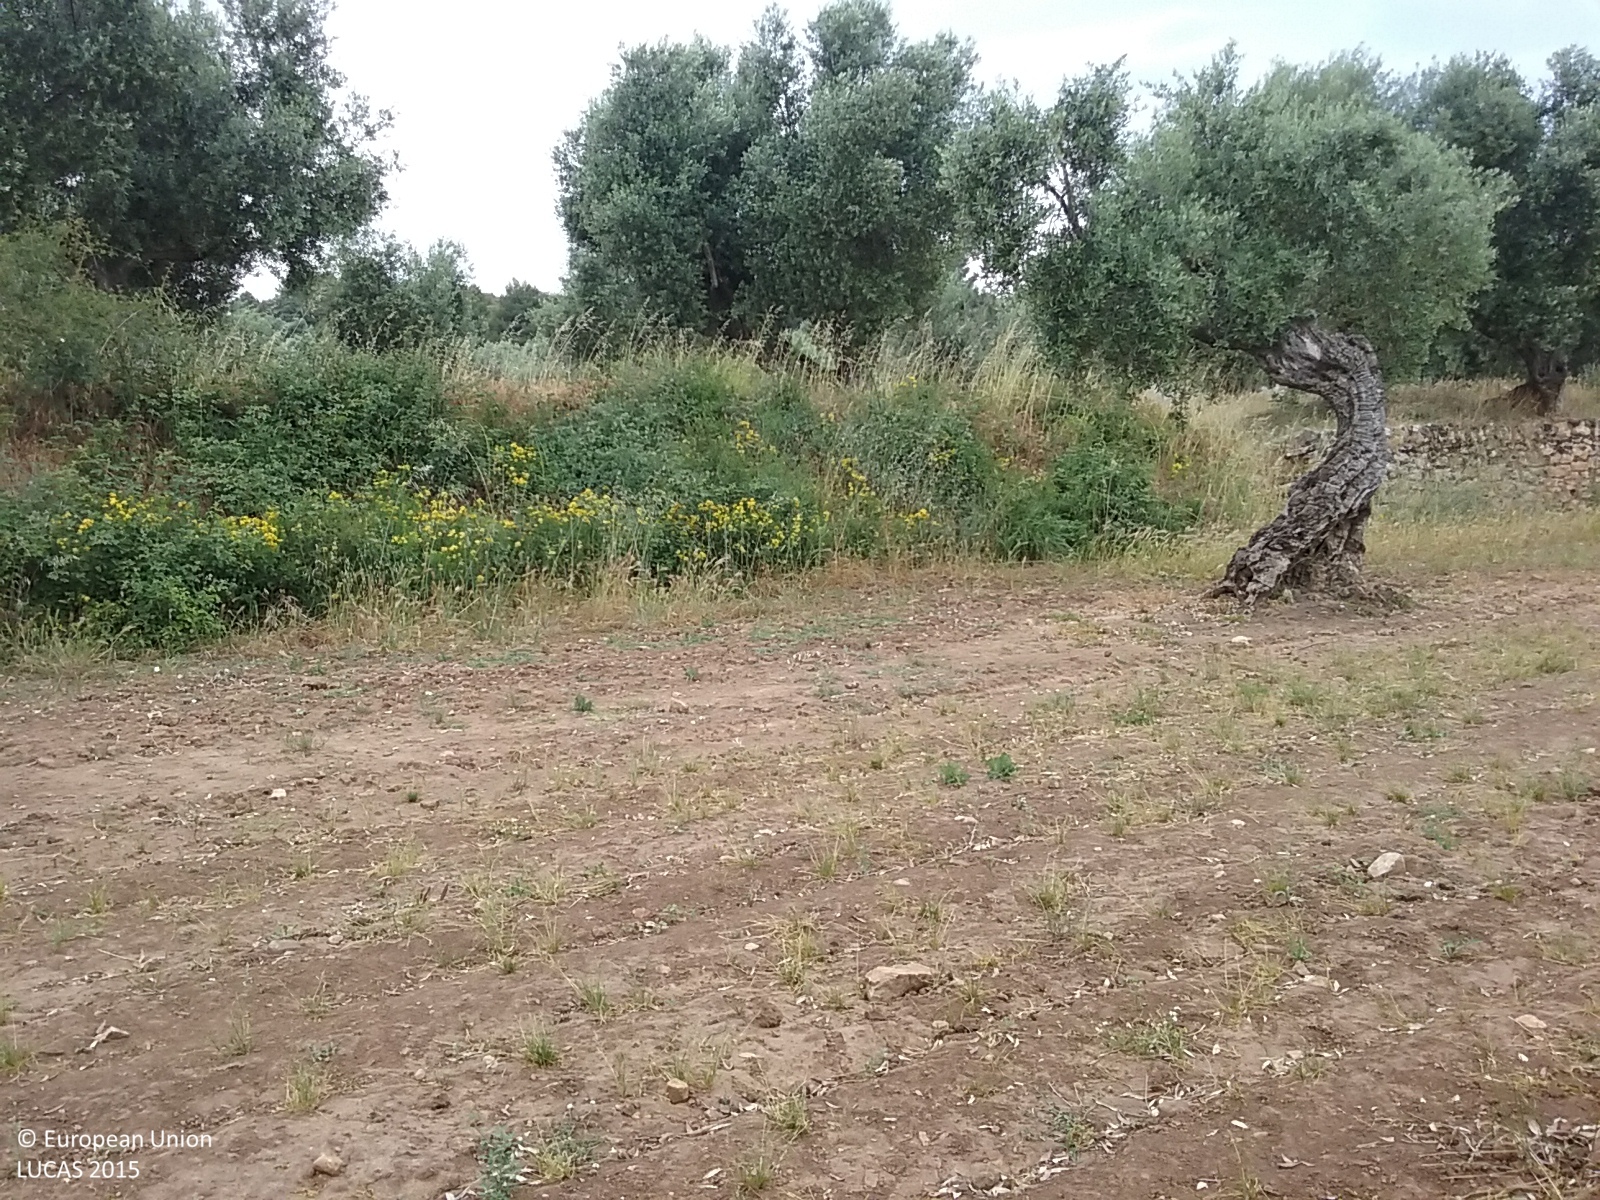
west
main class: Cropland
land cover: Olive groves
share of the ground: 25 - 50 %
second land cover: Spontaneously vegetated surfaces
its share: < 10 %
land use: Agriculture (excluding fallow land and kitchen gardens)
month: June
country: ES
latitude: 40.9221
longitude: 0.1950
